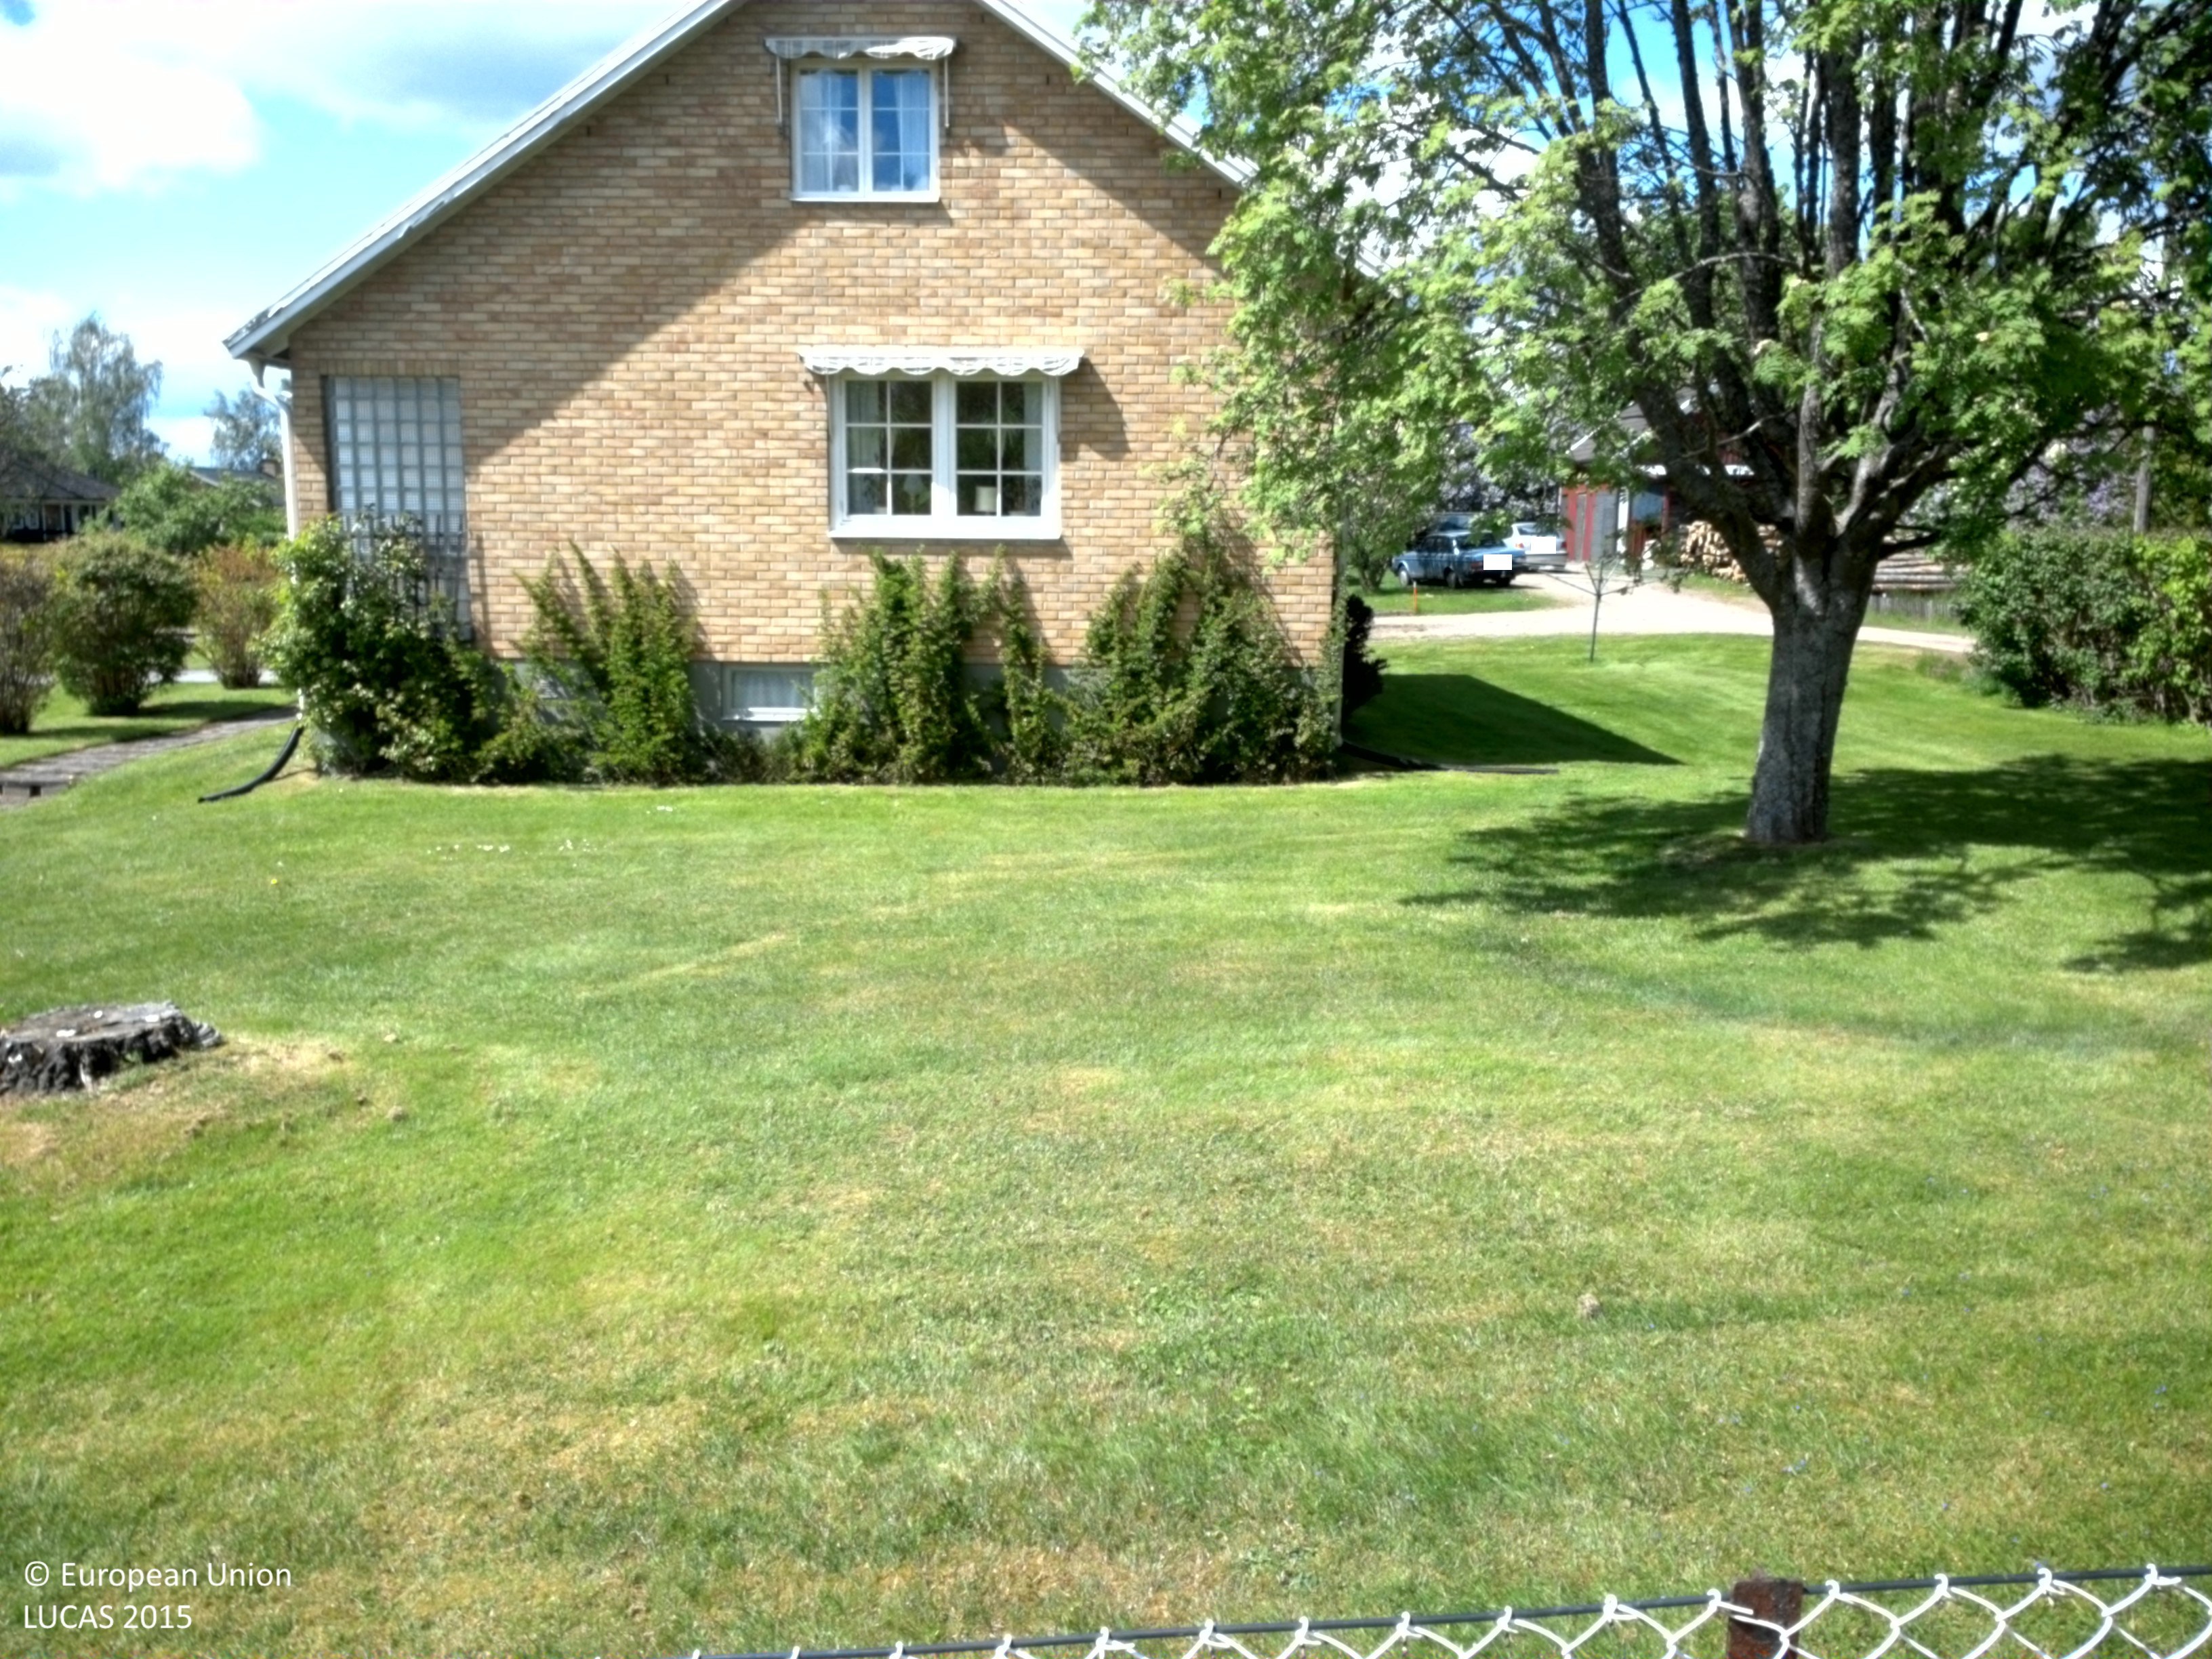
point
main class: Grassland
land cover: Grassland with sparse tree/shrub cover
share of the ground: > 75 %
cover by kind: herbaceous plants 80 %, broadleaved forest trees 5 %, shrubs 5 %, lichens and mosses 5 %, unconsolidated bare surface 5 %
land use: Residential
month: May
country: SE
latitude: 57.3162
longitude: 15.8591
